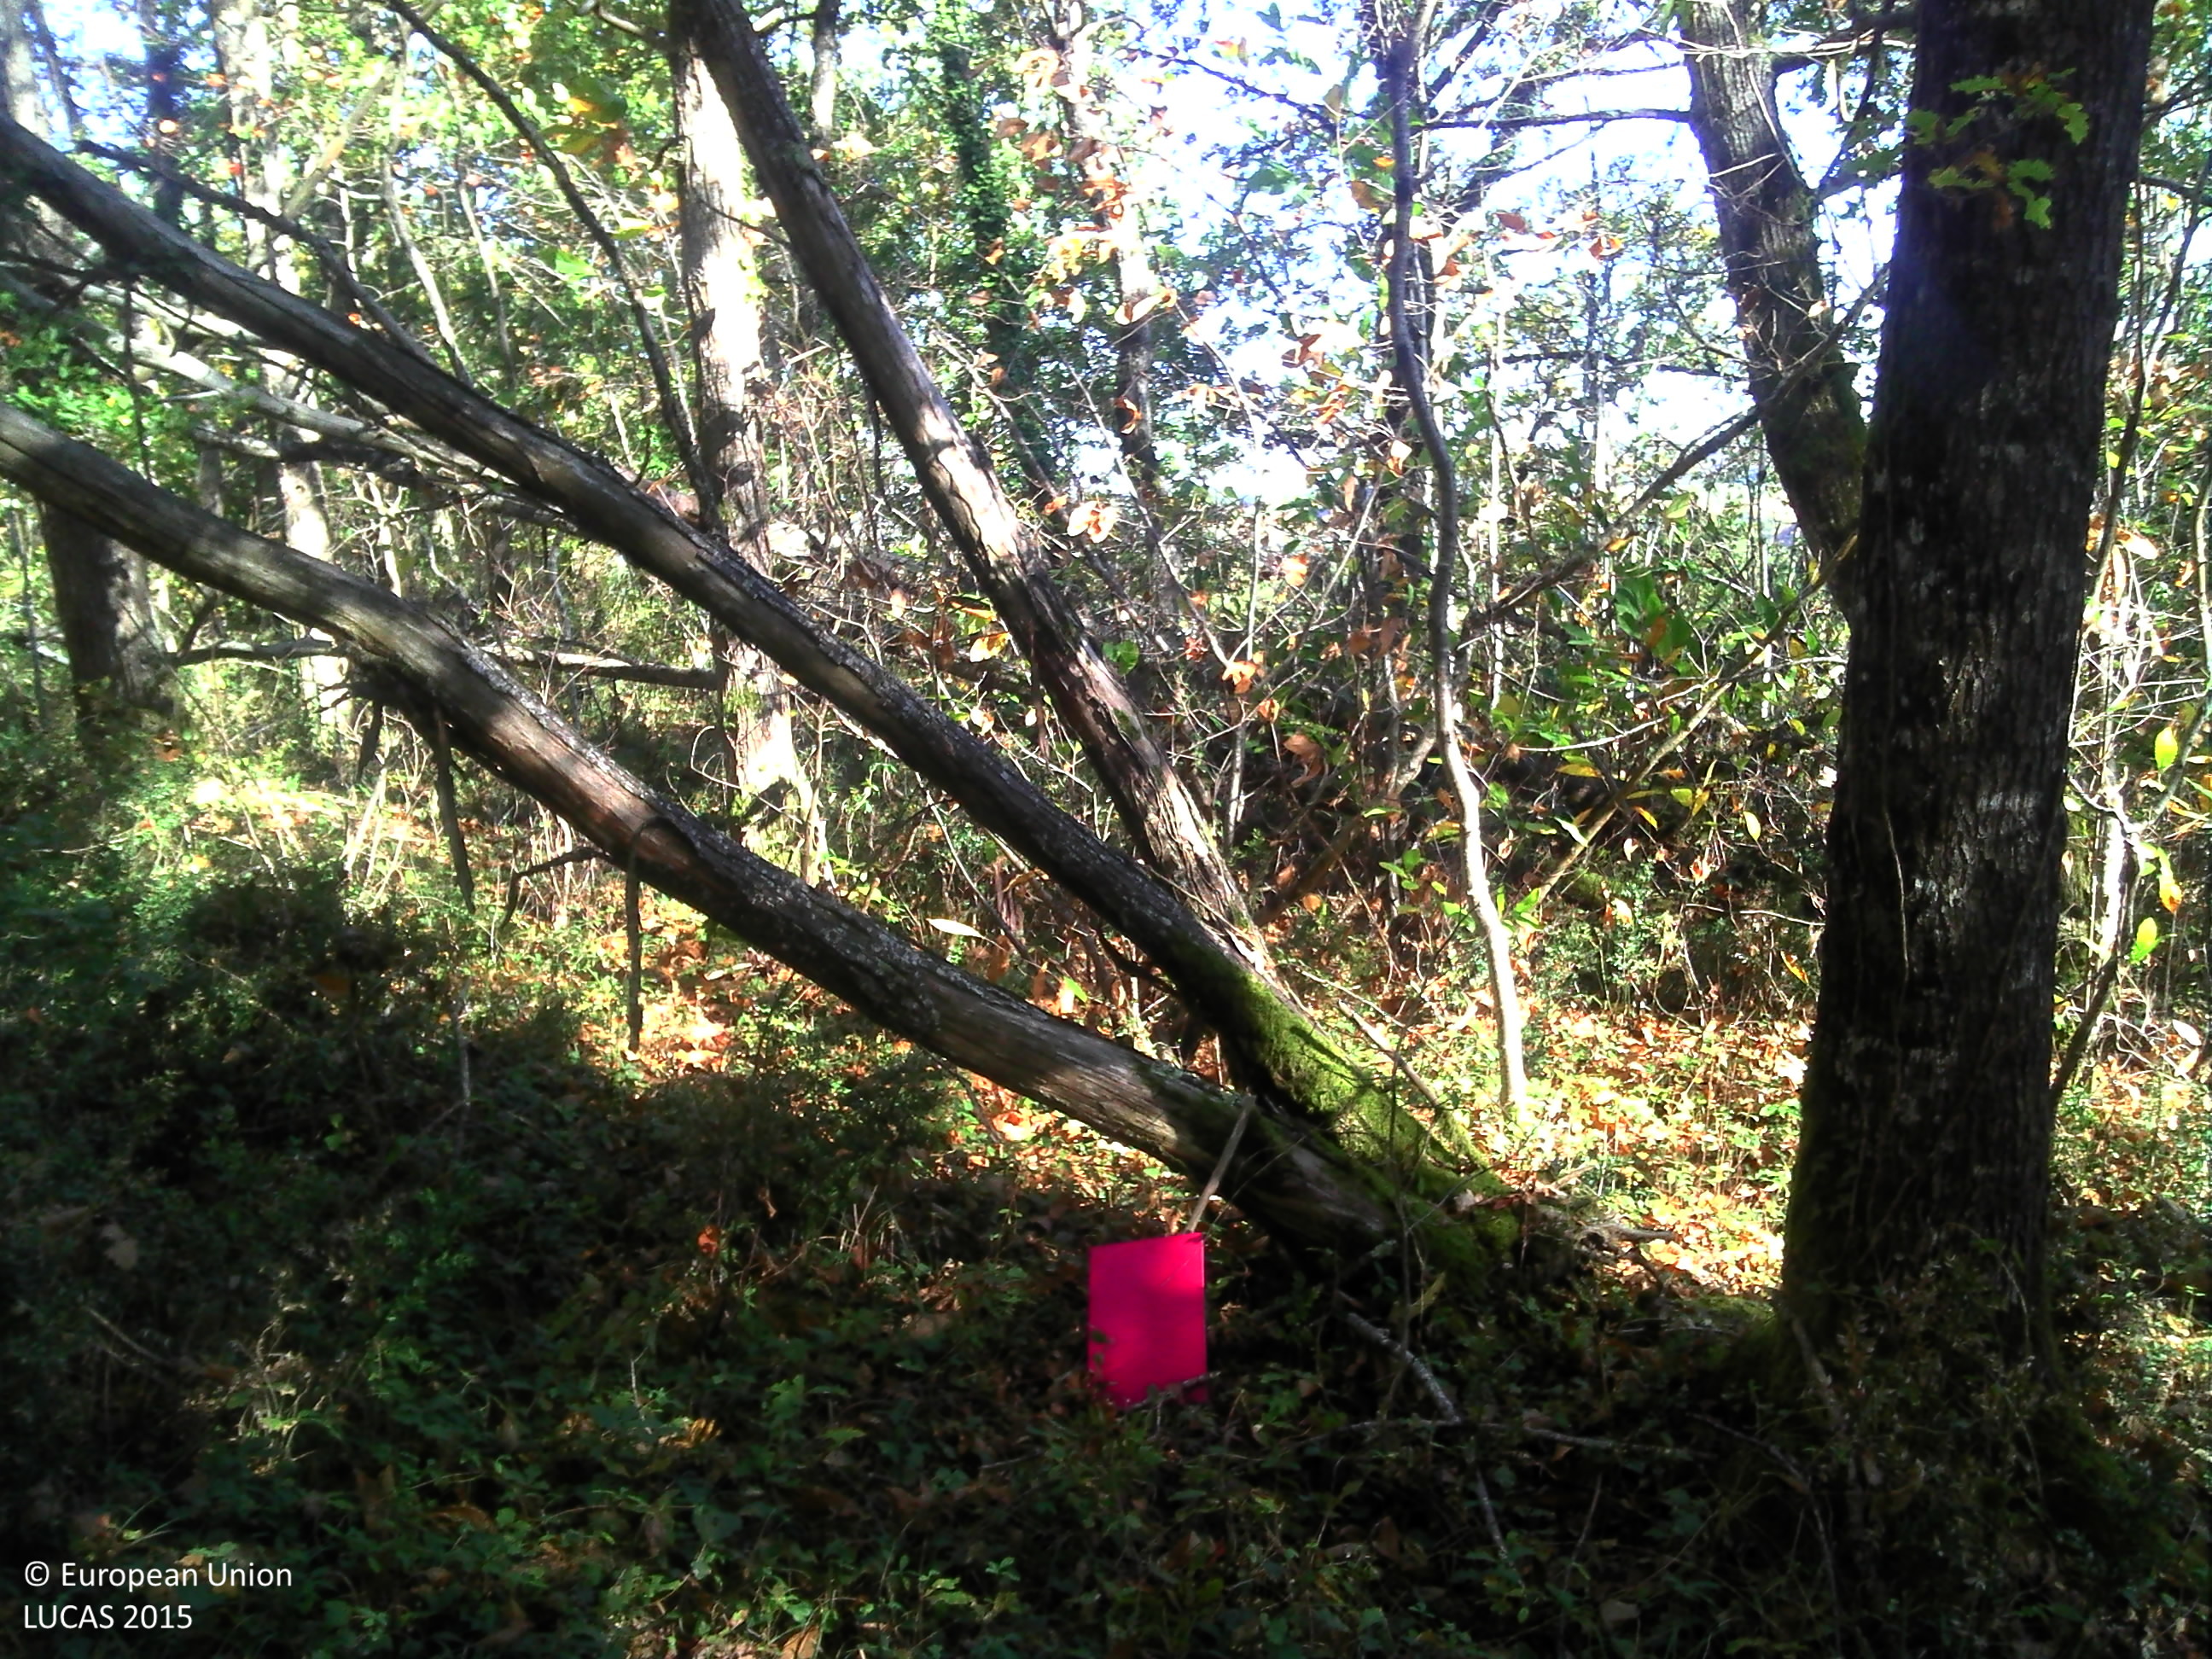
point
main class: Woodland
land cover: Broadleaved woodland
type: mesophytic deciduous forest
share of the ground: > 75 %
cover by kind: broadleaved forest trees 75 %, shrubs 15 %, herbaceous plants 5 %
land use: Forestry
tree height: > 5 m
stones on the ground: < 10 %
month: October
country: FR
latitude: 44.0206
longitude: 0.8779
